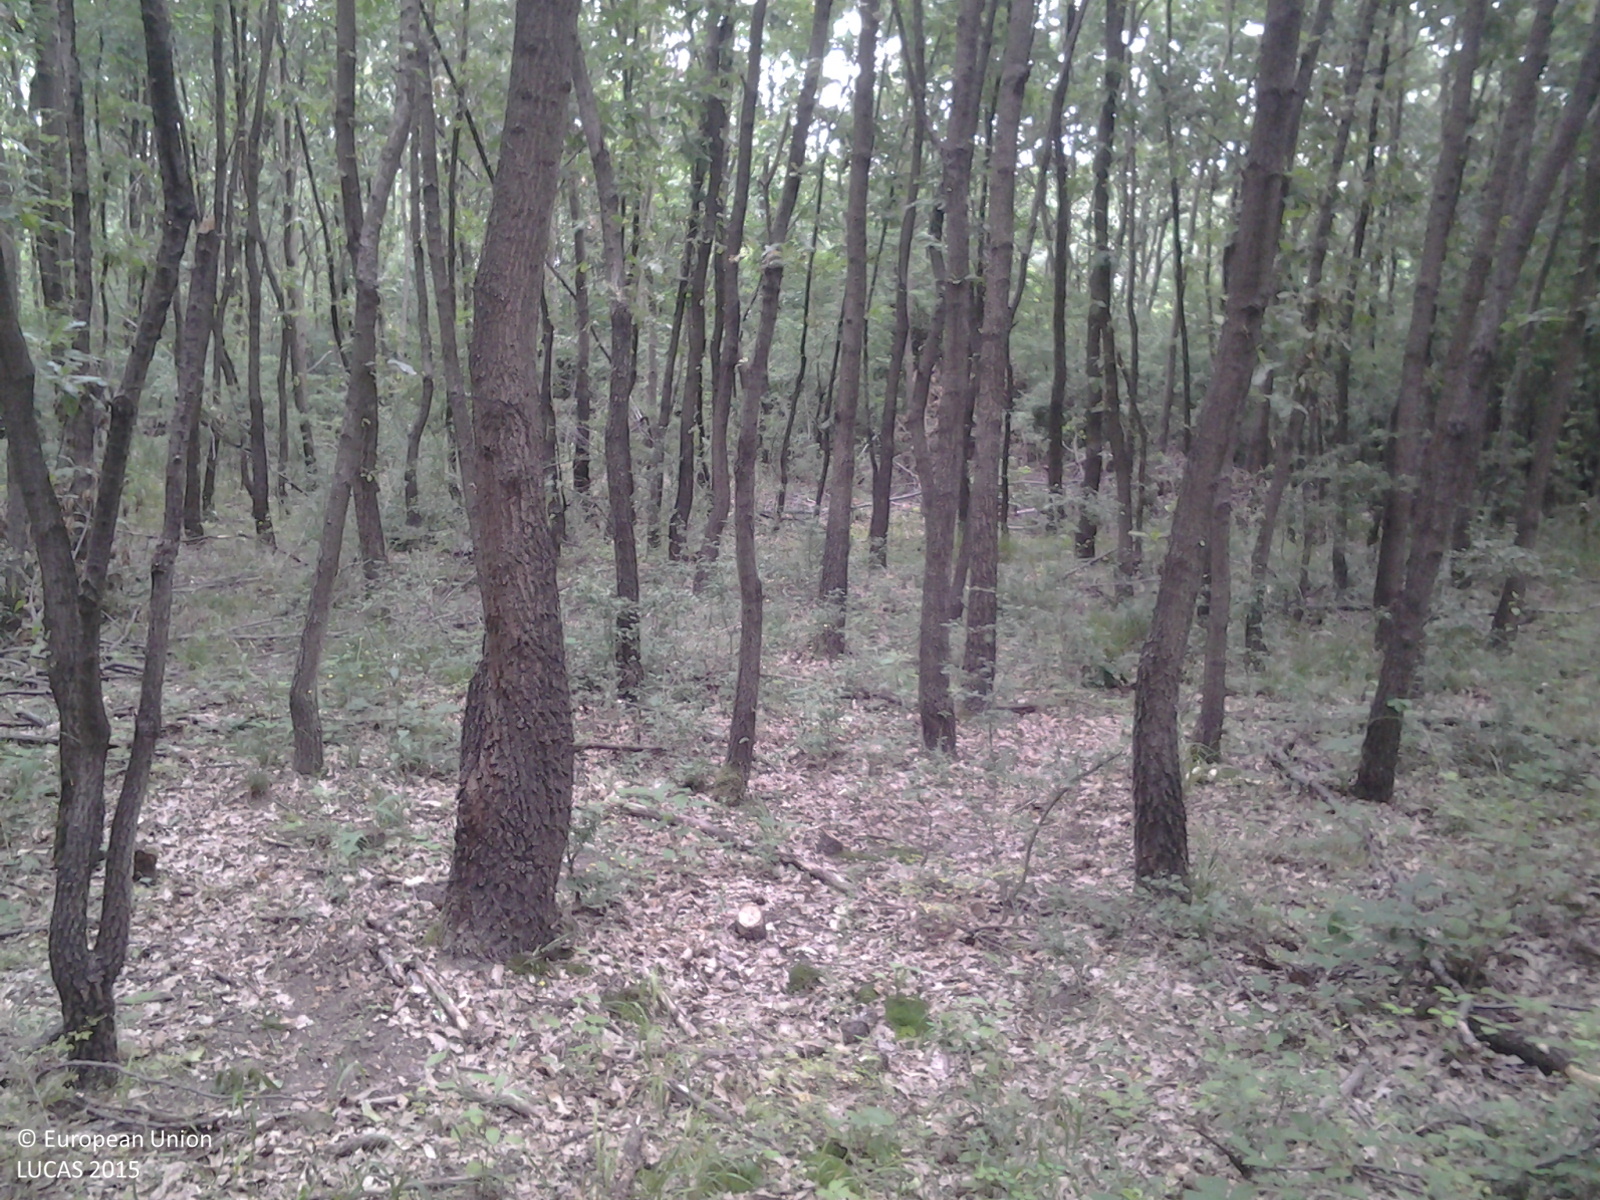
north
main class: Woodland
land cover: Broadleaved woodland
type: acidophilous oak and oak-birch forest
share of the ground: > 75 %
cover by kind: broadleaved forest trees 90 %, herbaceous plants 10 %
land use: Forestry
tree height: > 5 m
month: June
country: HU
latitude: 47.1734
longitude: 17.4879
